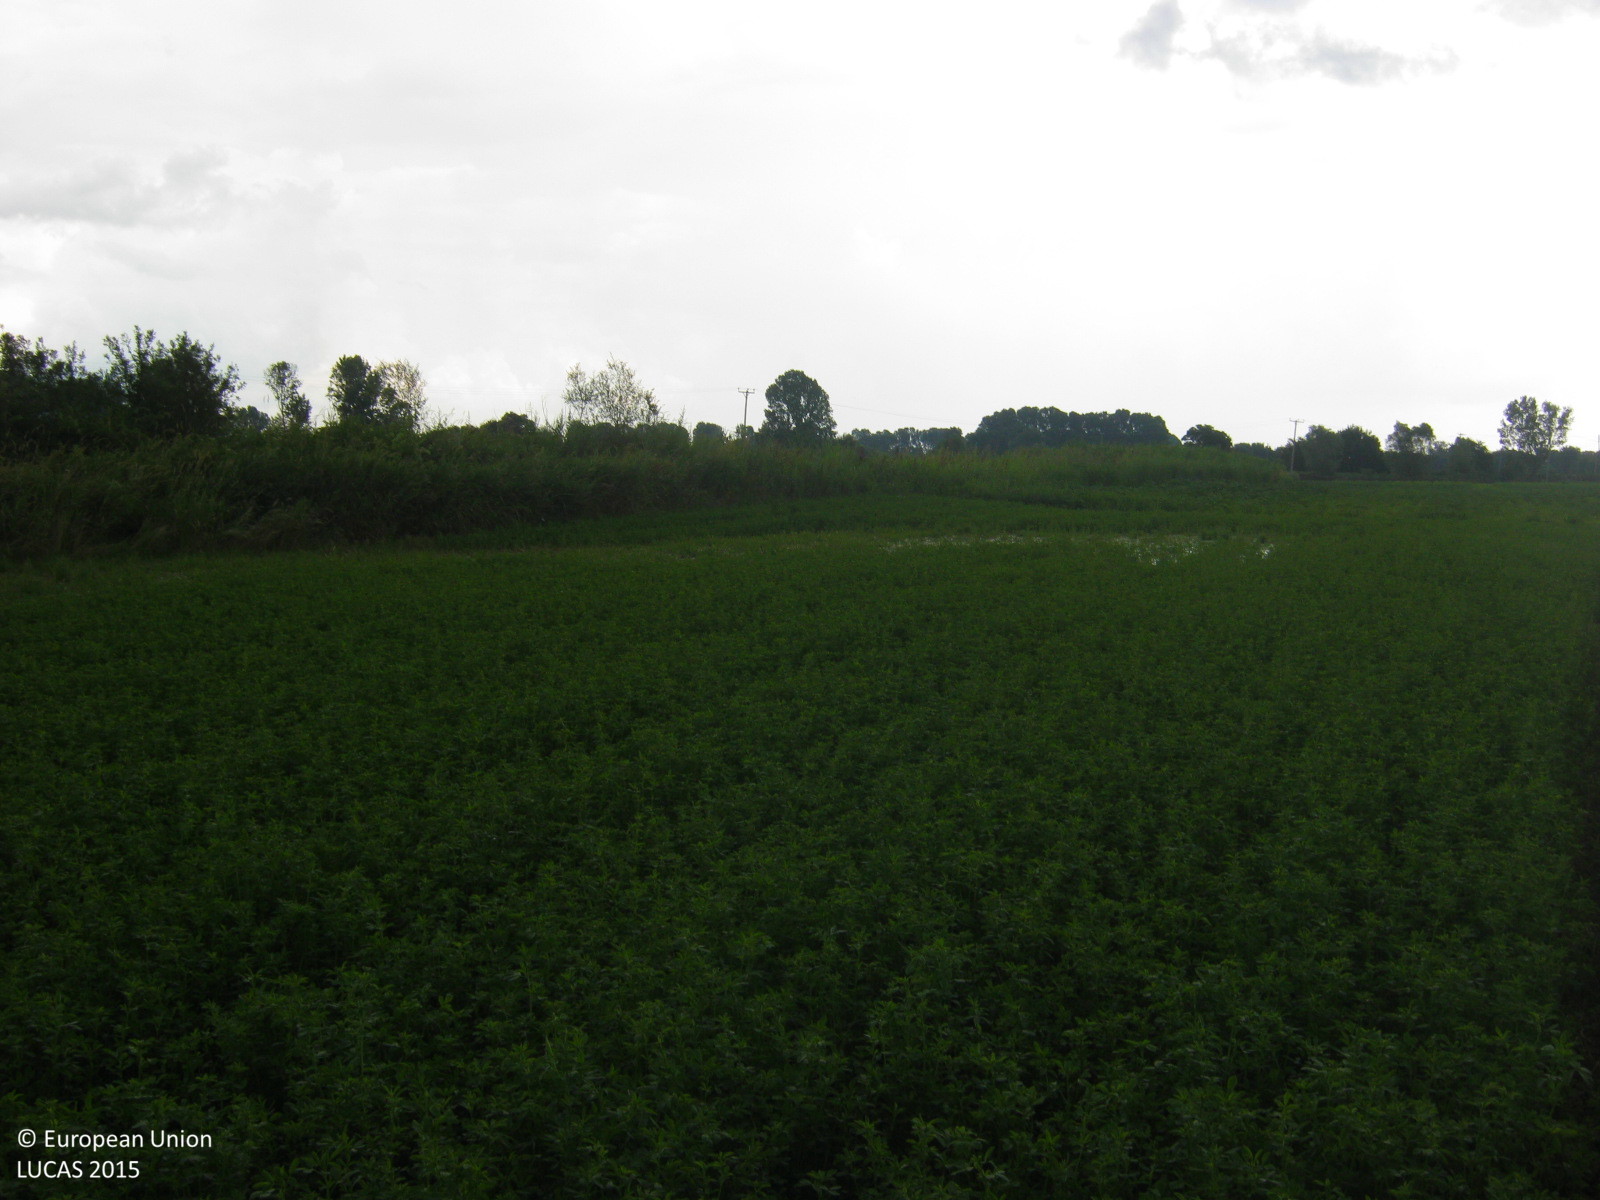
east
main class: Cropland
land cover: Lucerne
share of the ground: > 75 %
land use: Agriculture (excluding fallow land and kitchen gardens)
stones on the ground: < 10 %
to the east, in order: Lucerne; Shruby margins; Ditches and canals; Shruby margins; Sunflower; Electric lines; Sunflower; Grass margins; Tracks; Maize
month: June
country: GR
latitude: 41.1097
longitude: 24.9877
